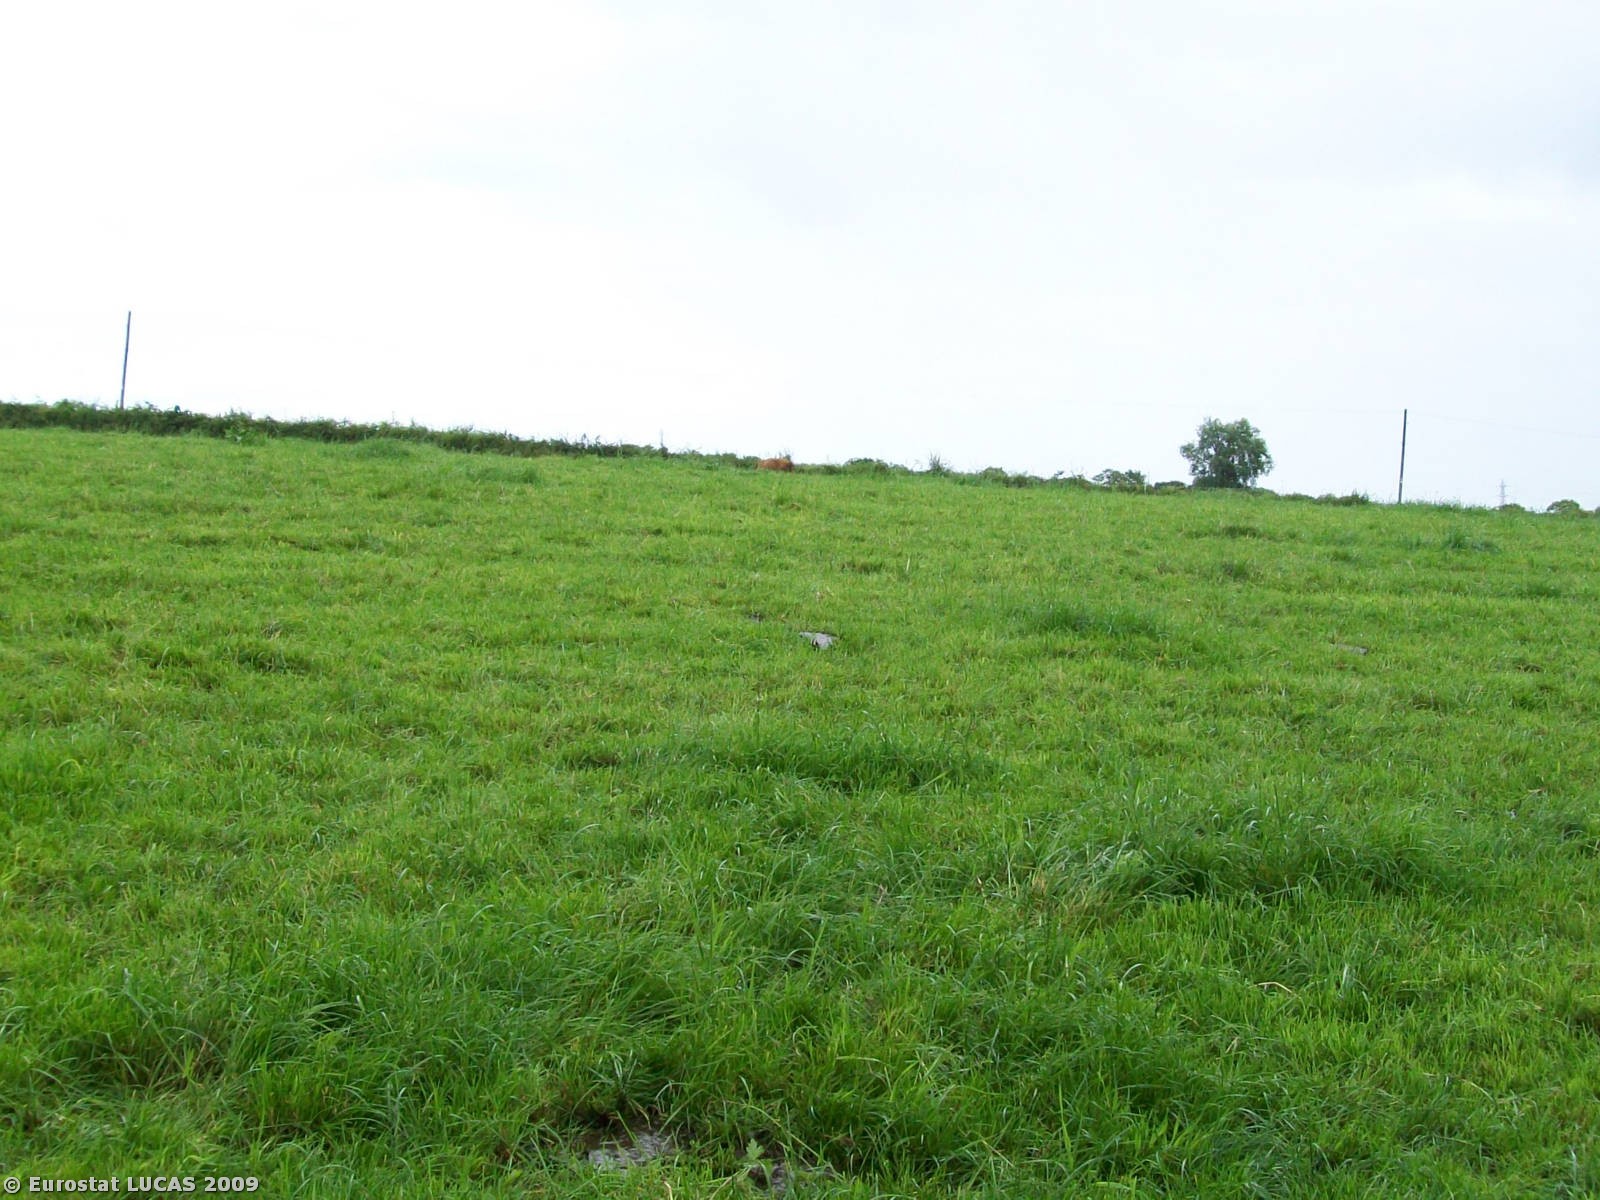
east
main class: Grassland
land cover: Grassland without tree/shrub cover
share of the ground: > 75 %
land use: Agriculture (excluding fallow land and kitchen gardens)
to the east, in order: Grassland without tree/shrub cover; Rivers and streams; Managed hedges; Grass margins; Paved roads, cycling and walking lanes; Grass margins; Electric lines; Fences; Grassland without tree/shrub cover; Fences; Grass margins; Rivers and streams; Grassland without tree/shrub cover
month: July
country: GB
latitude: 54.7357
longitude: -5.8376
